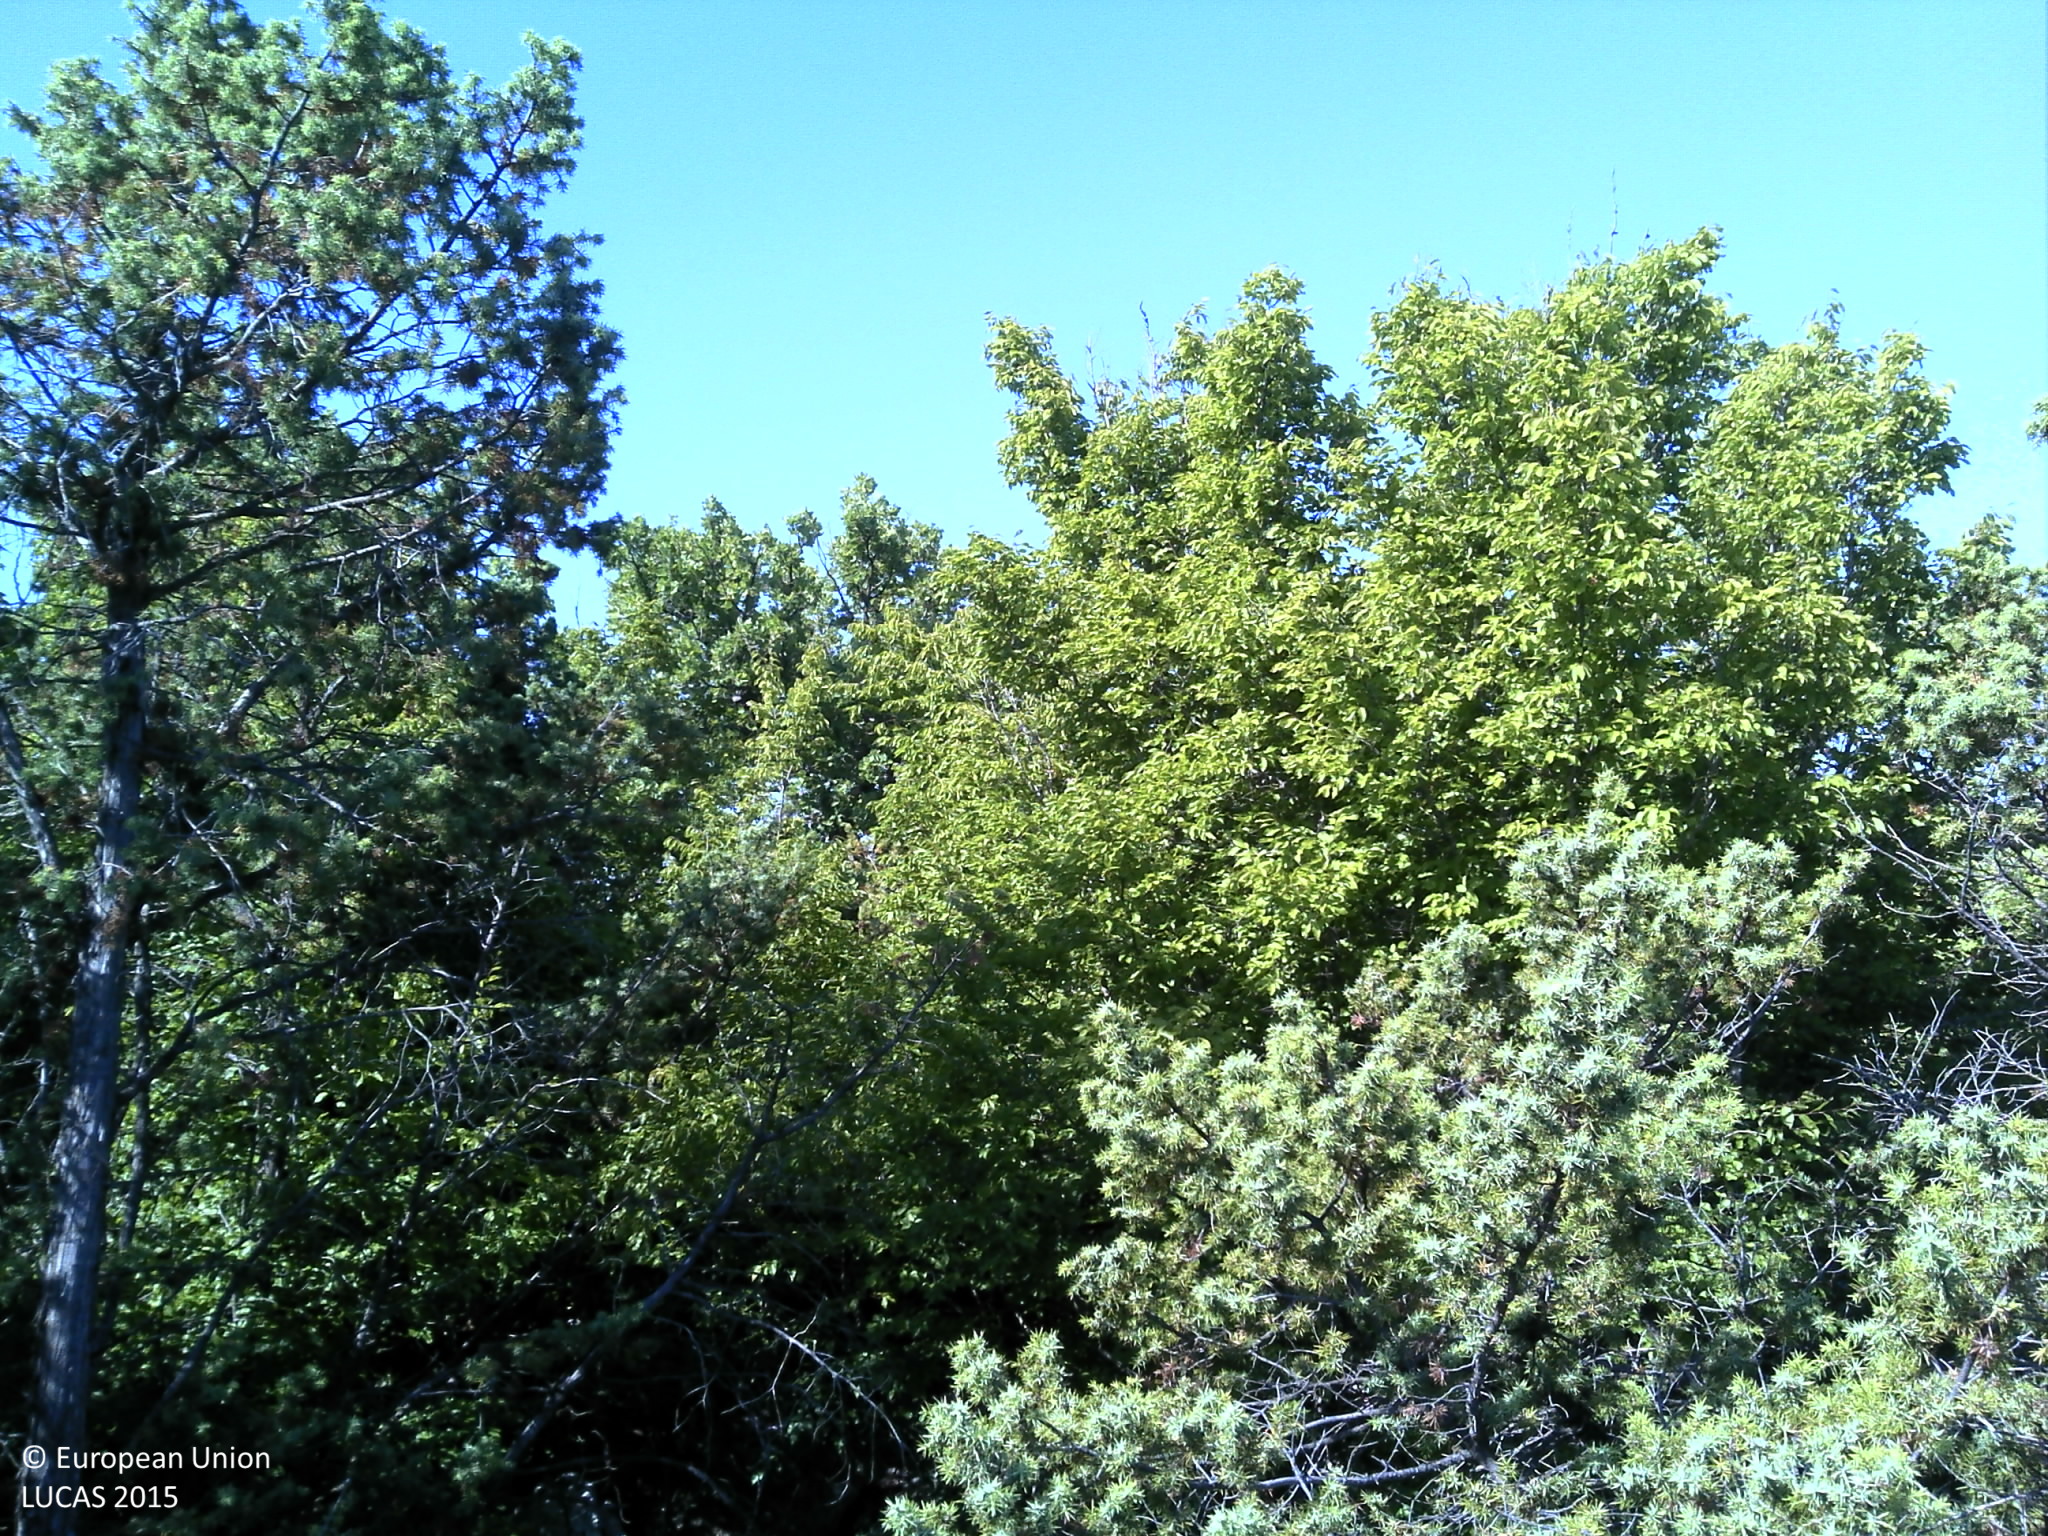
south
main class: Shrubland
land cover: Shrubland with sparse tree cover
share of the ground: > 75 %
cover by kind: shrubs 75 %, consolidated bare surface 20 %, broadleaved forest trees 5 %
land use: Semi-natural and natural areas not in use
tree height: > 5 m
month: July
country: HR
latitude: 43.8291
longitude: 16.0724
